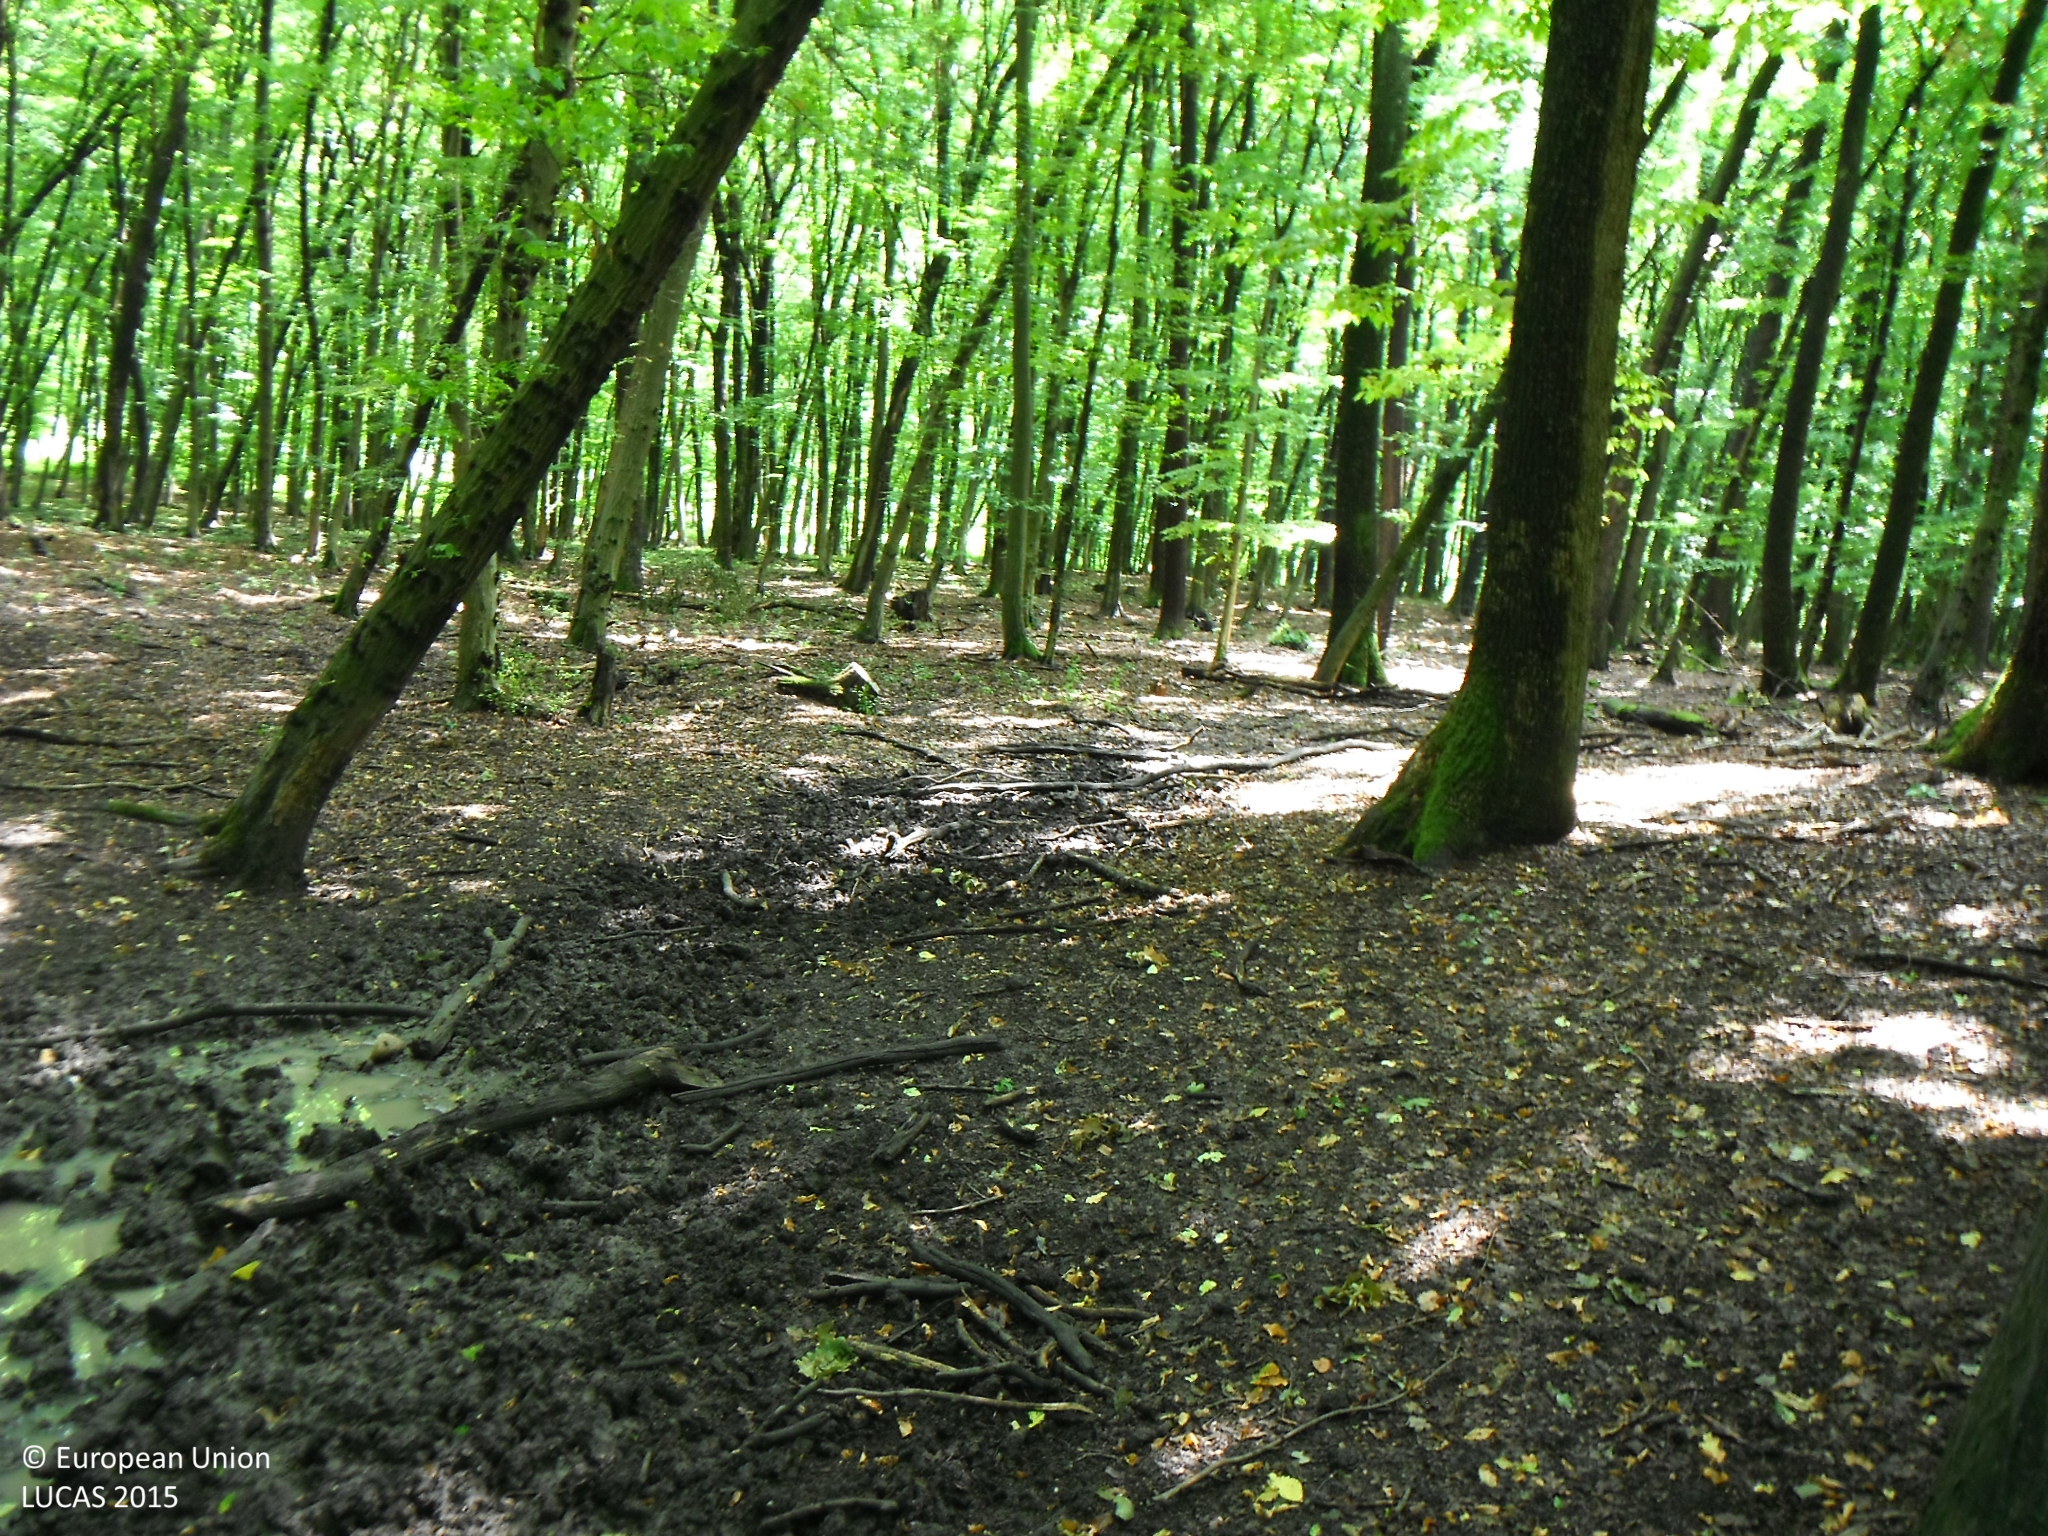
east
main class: Woodland
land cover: Broadleaved woodland
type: mesophytic deciduous forest
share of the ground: > 75 %
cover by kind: broadleaved forest trees 100 %
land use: Forestry
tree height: > 5 m
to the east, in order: Broadleaved woodland; Tracks; Broadleaved woodland; Ditches and canals; Broadleaved woodland
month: July
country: SK
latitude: 48.7234
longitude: 21.3694
